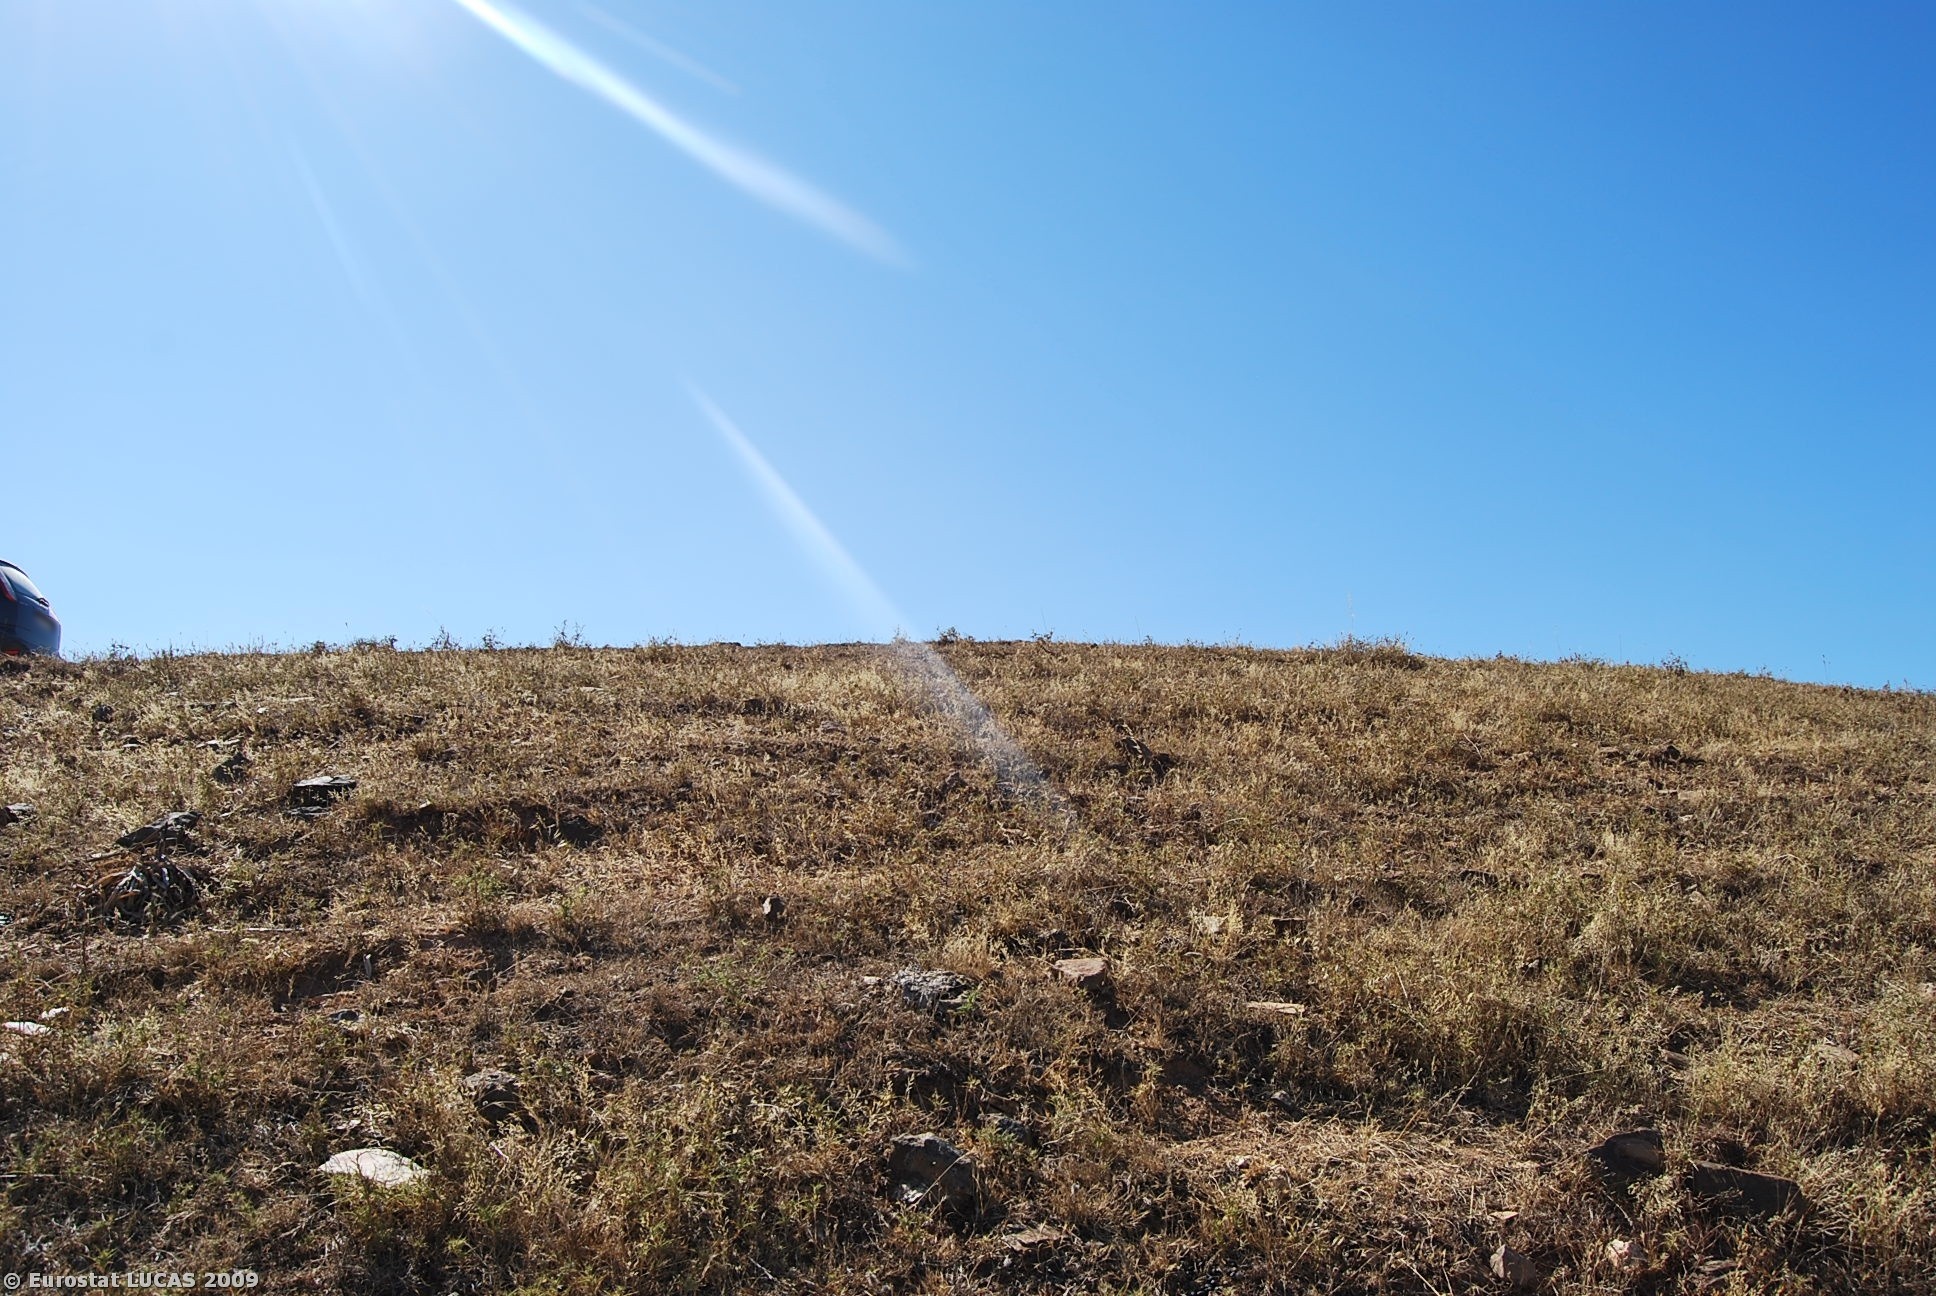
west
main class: Grassland
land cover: Grassland without tree/shrub cover
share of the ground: > 75 %
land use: Agriculture (excluding fallow land and kitchen gardens)
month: July
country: PT
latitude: 37.5826
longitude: -8.5967
